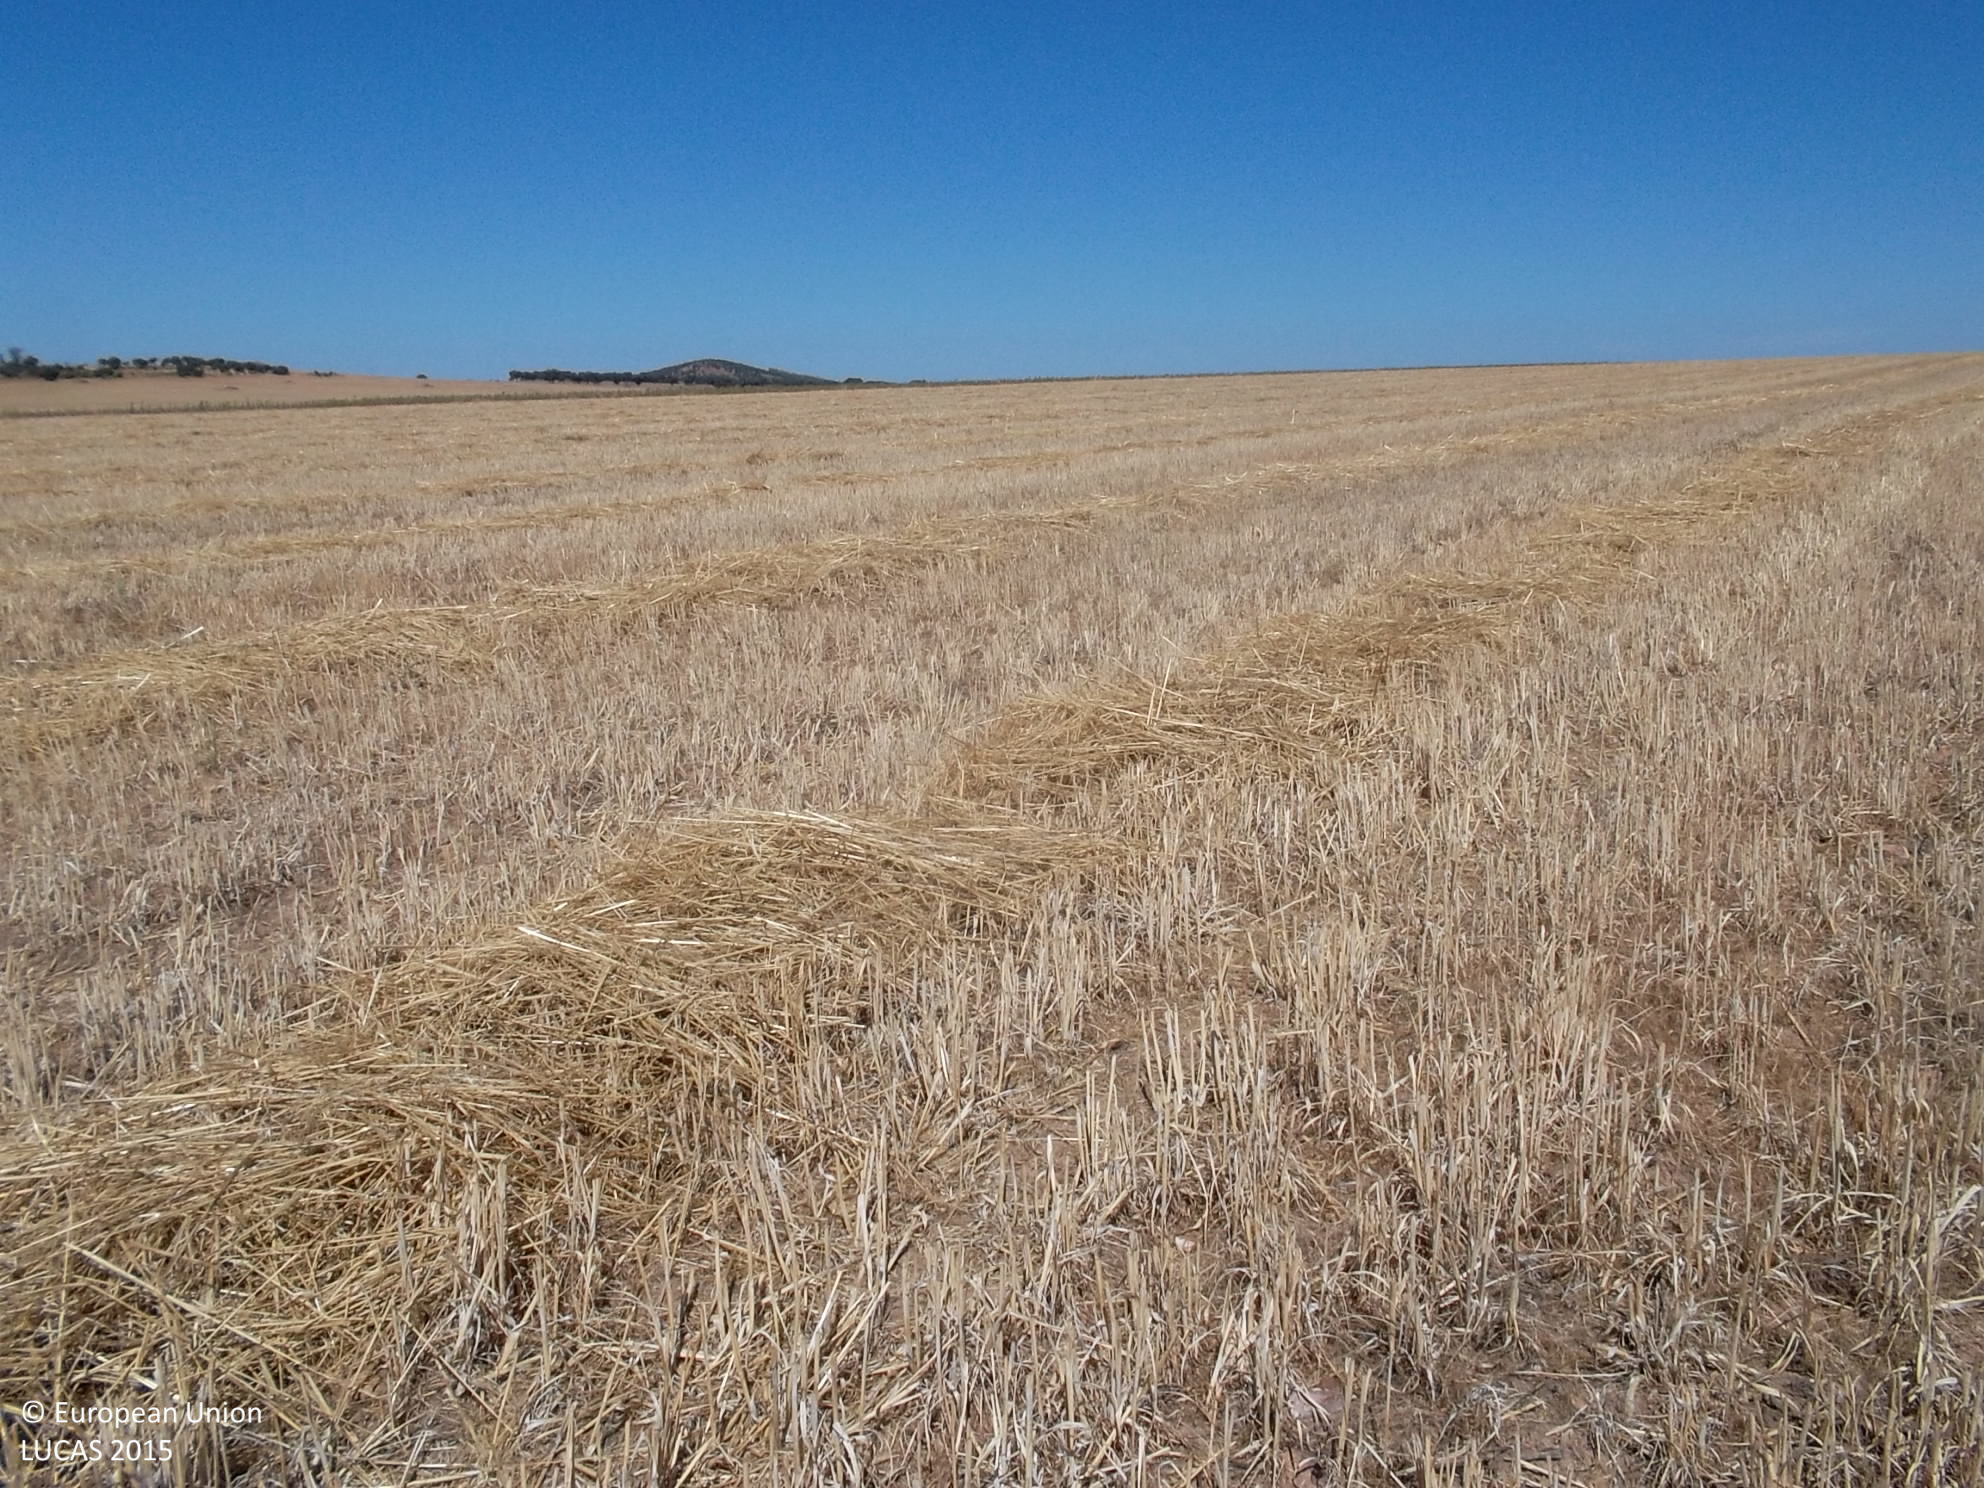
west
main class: Cropland
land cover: Oats
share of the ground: < 10 %
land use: Agriculture (excluding fallow land and kitchen gardens)
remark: Harvested field
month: July
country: ES
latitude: 38.4601
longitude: -5.7040
